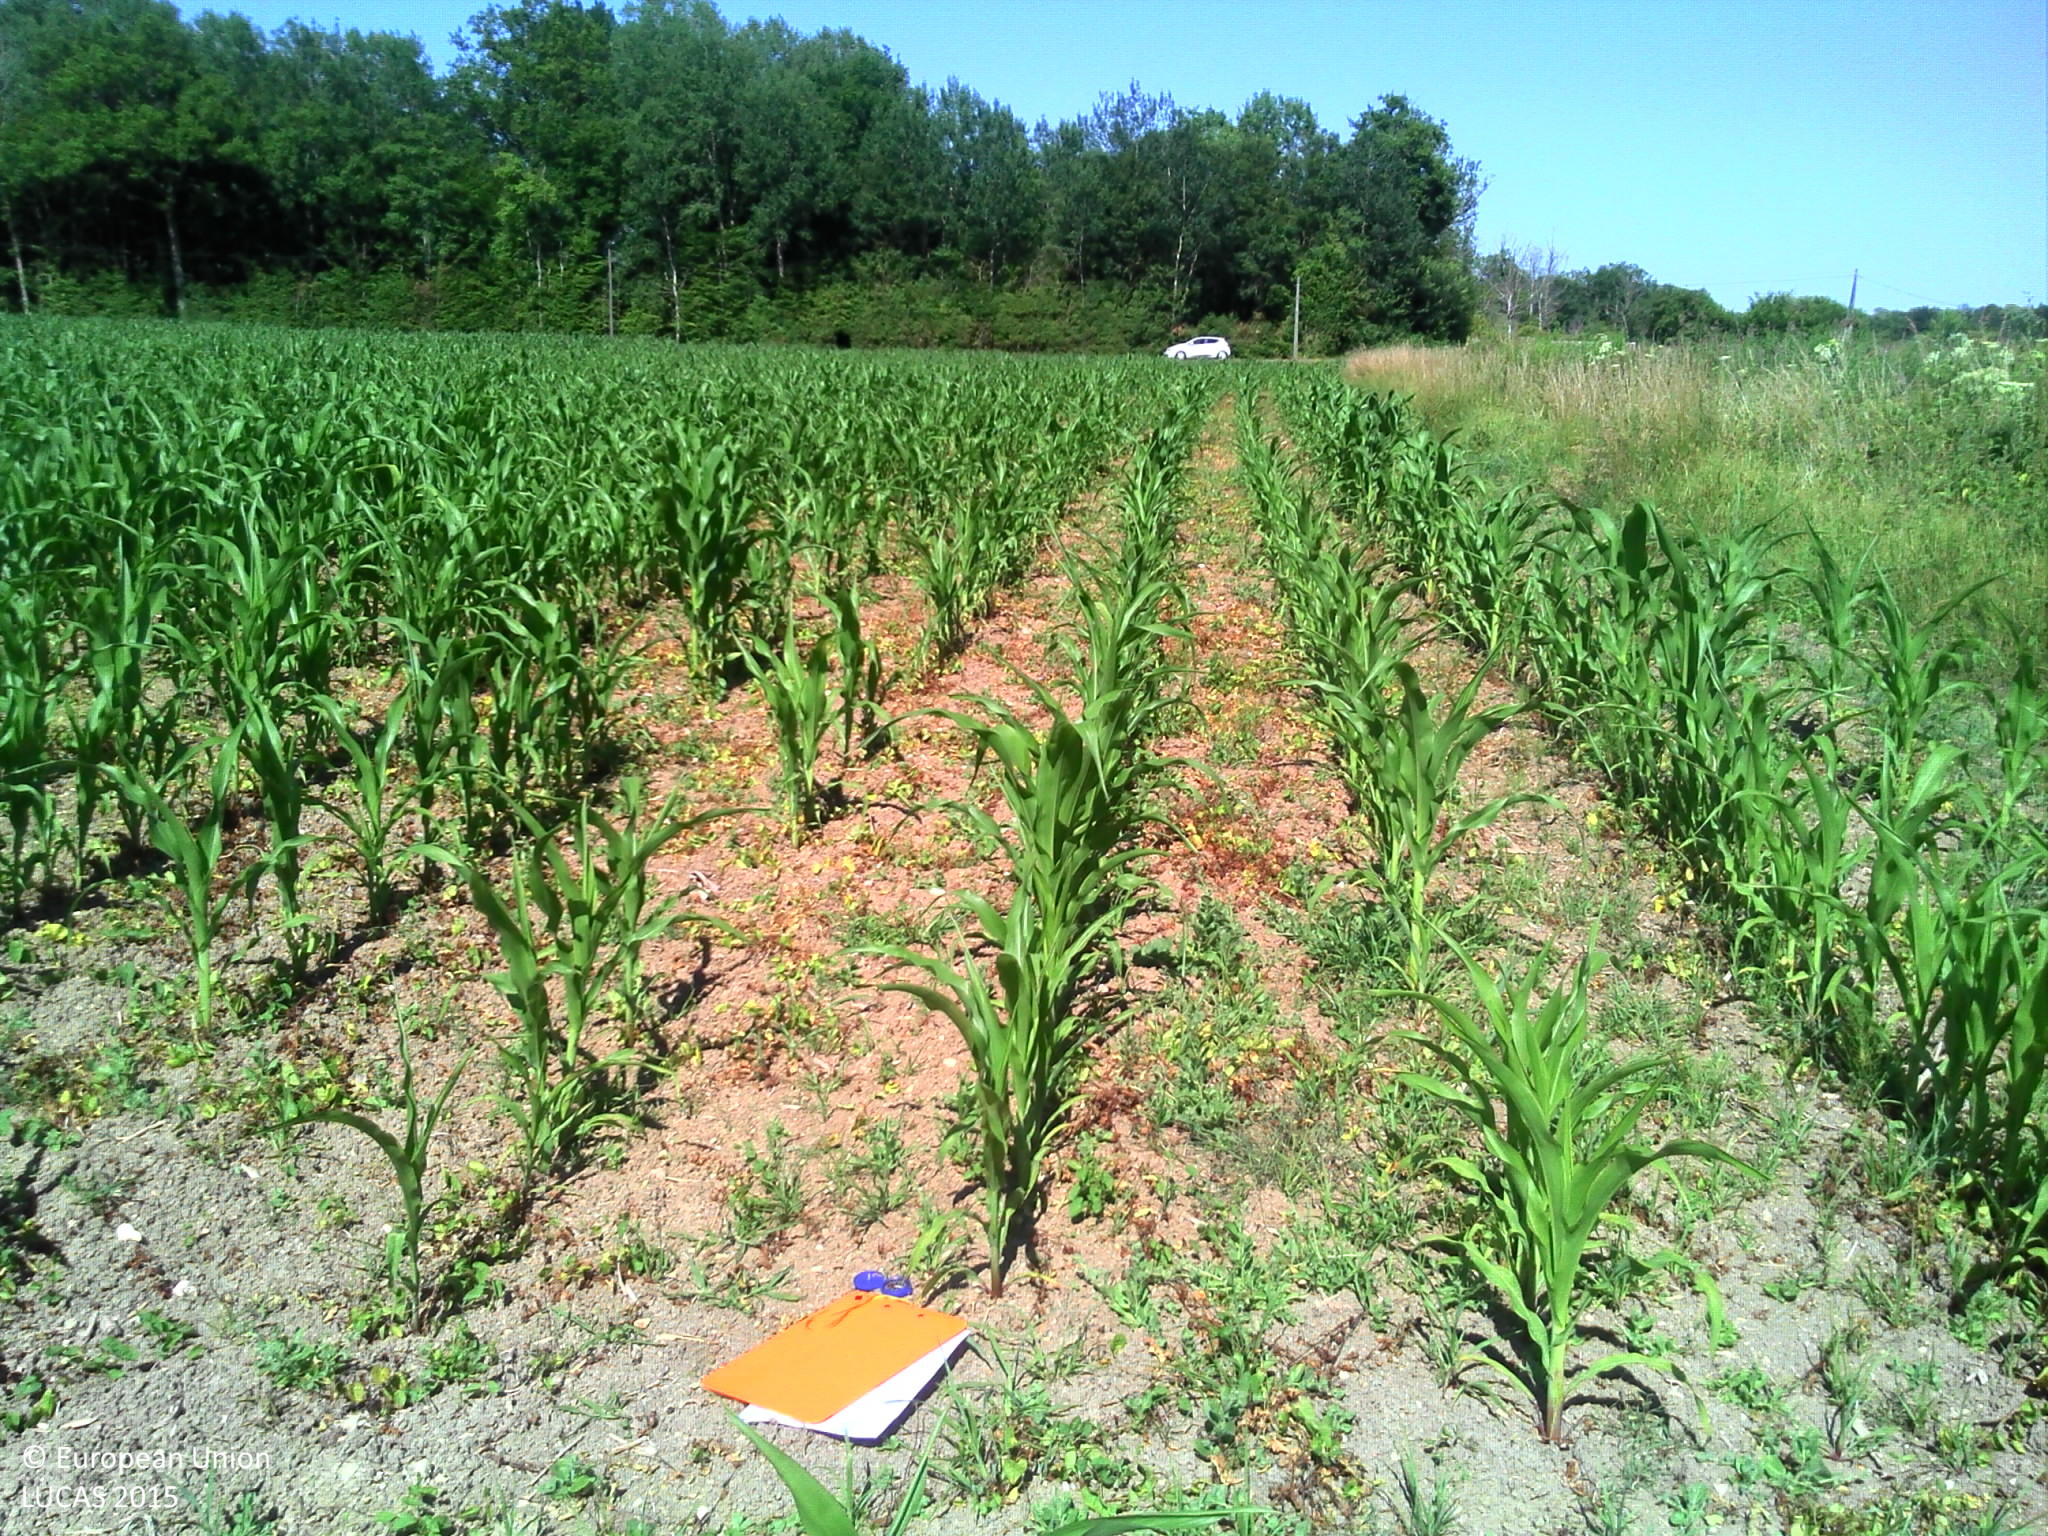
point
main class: Cropland
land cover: Maize
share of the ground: 50 - 75 %
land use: Agriculture (excluding fallow land and kitchen gardens)
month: June
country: FR
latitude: 47.7013
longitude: 2.8369
